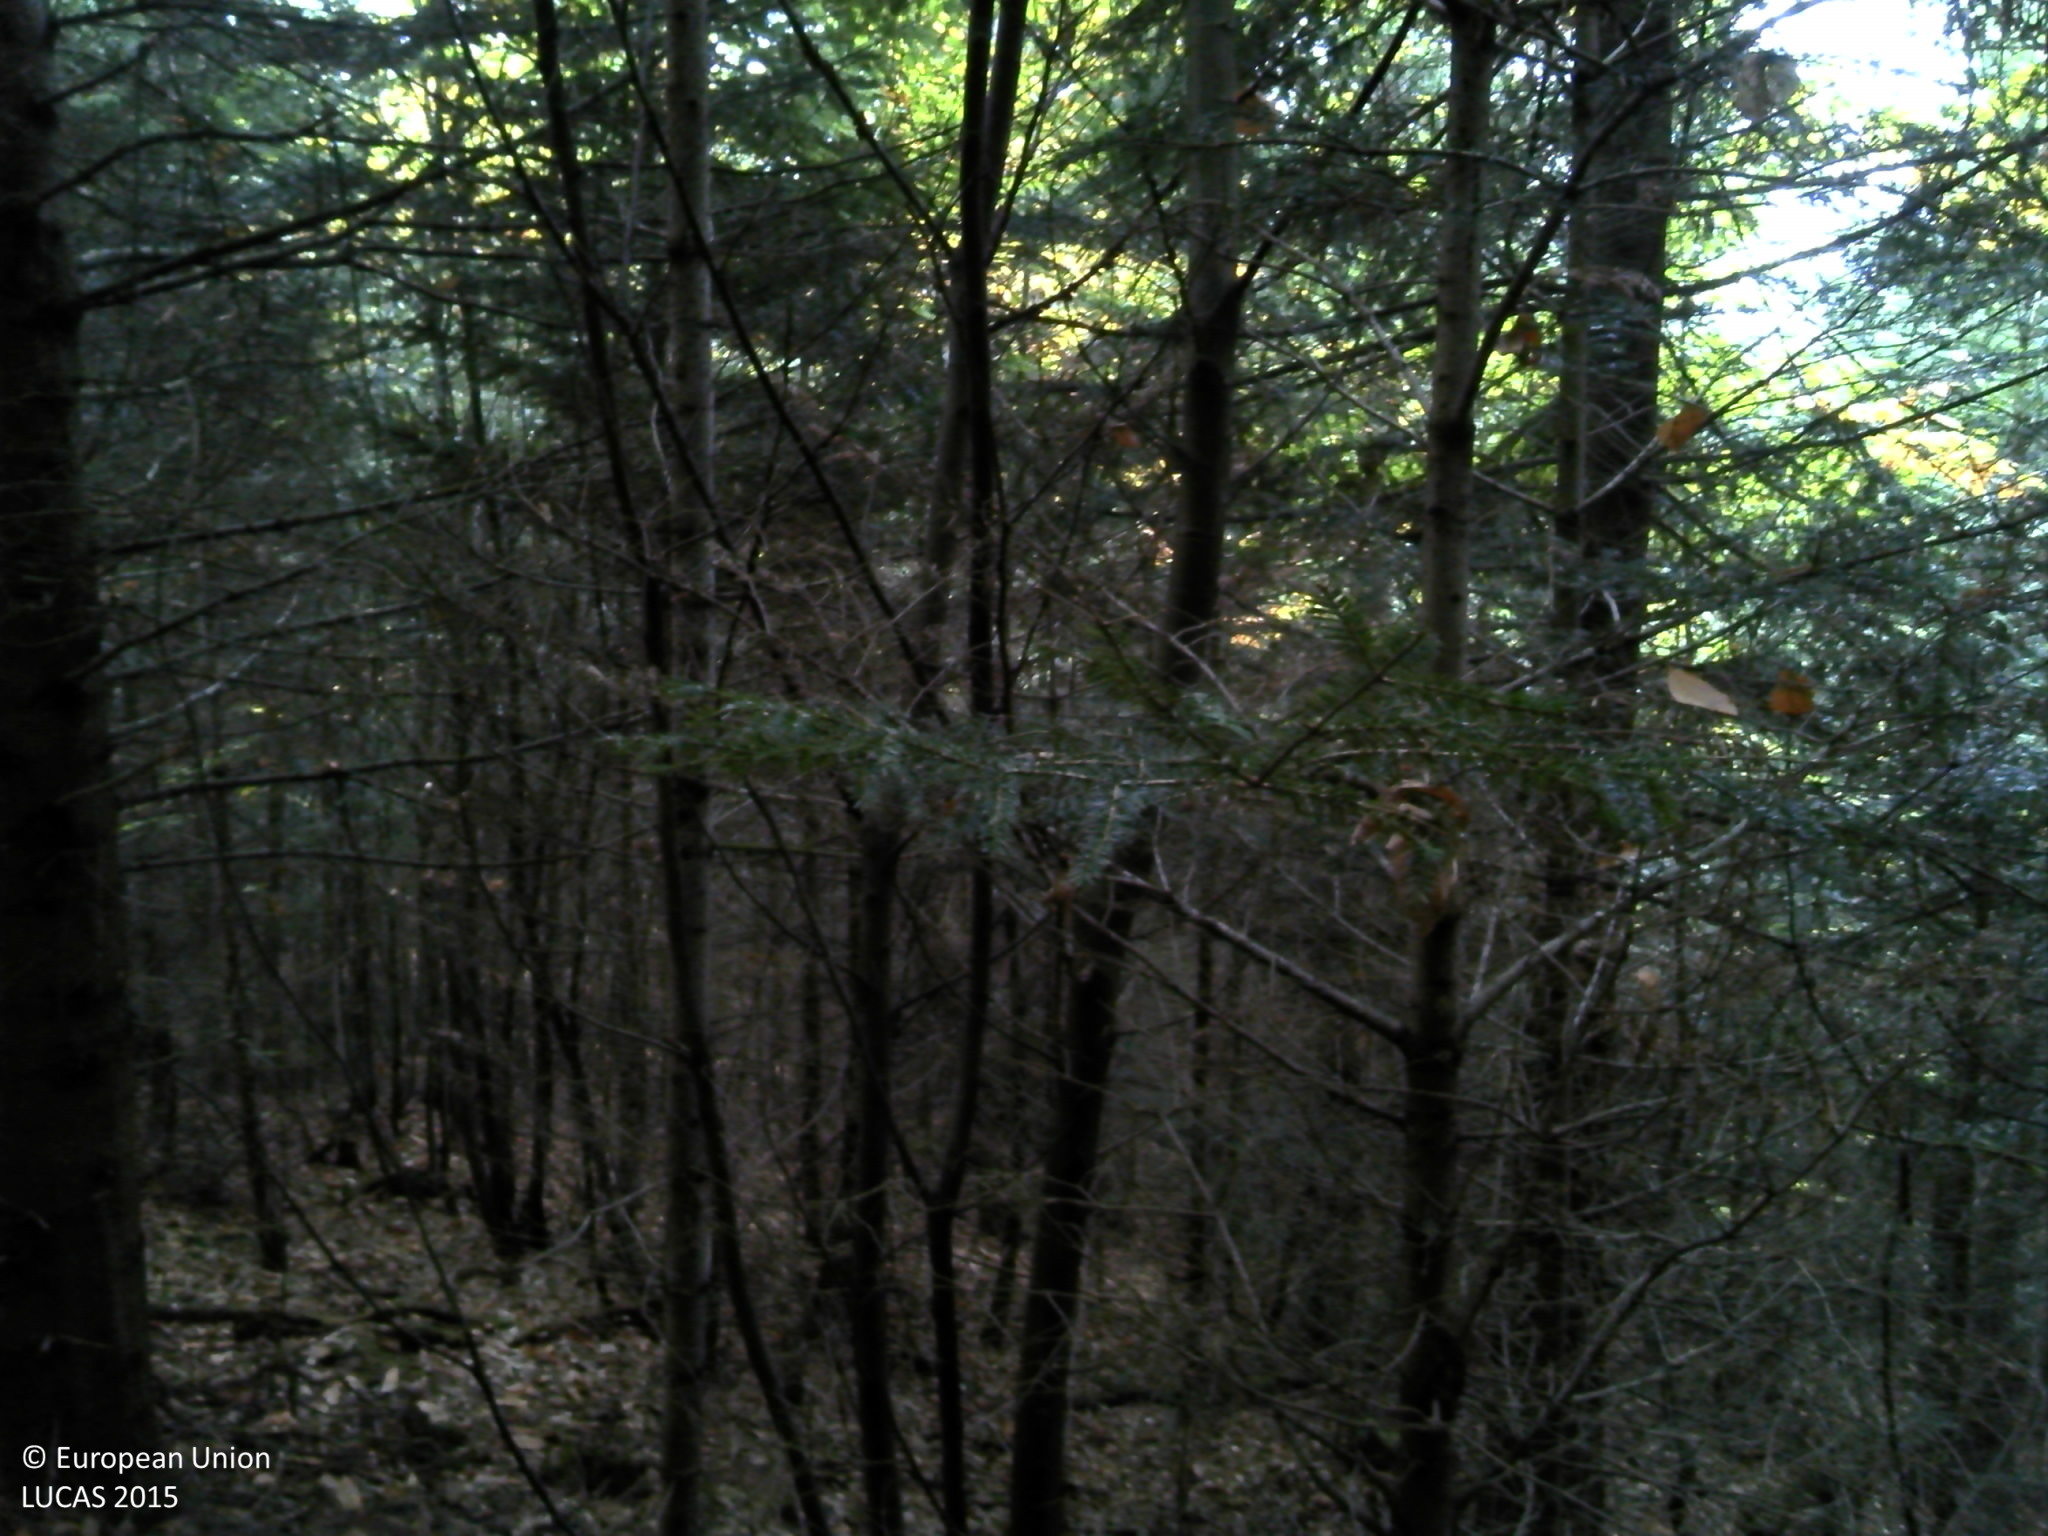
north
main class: Woodland
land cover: Spruce dominated mixed woodland
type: alpine coniferous forest
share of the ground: > 75 %
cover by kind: coniferous forest trees 60 %, broadleaved forest trees 30 %, unconsolidated bare surface 10 %
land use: Forestry
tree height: > 5 m
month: October
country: FR
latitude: 45.5729
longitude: 3.7617
